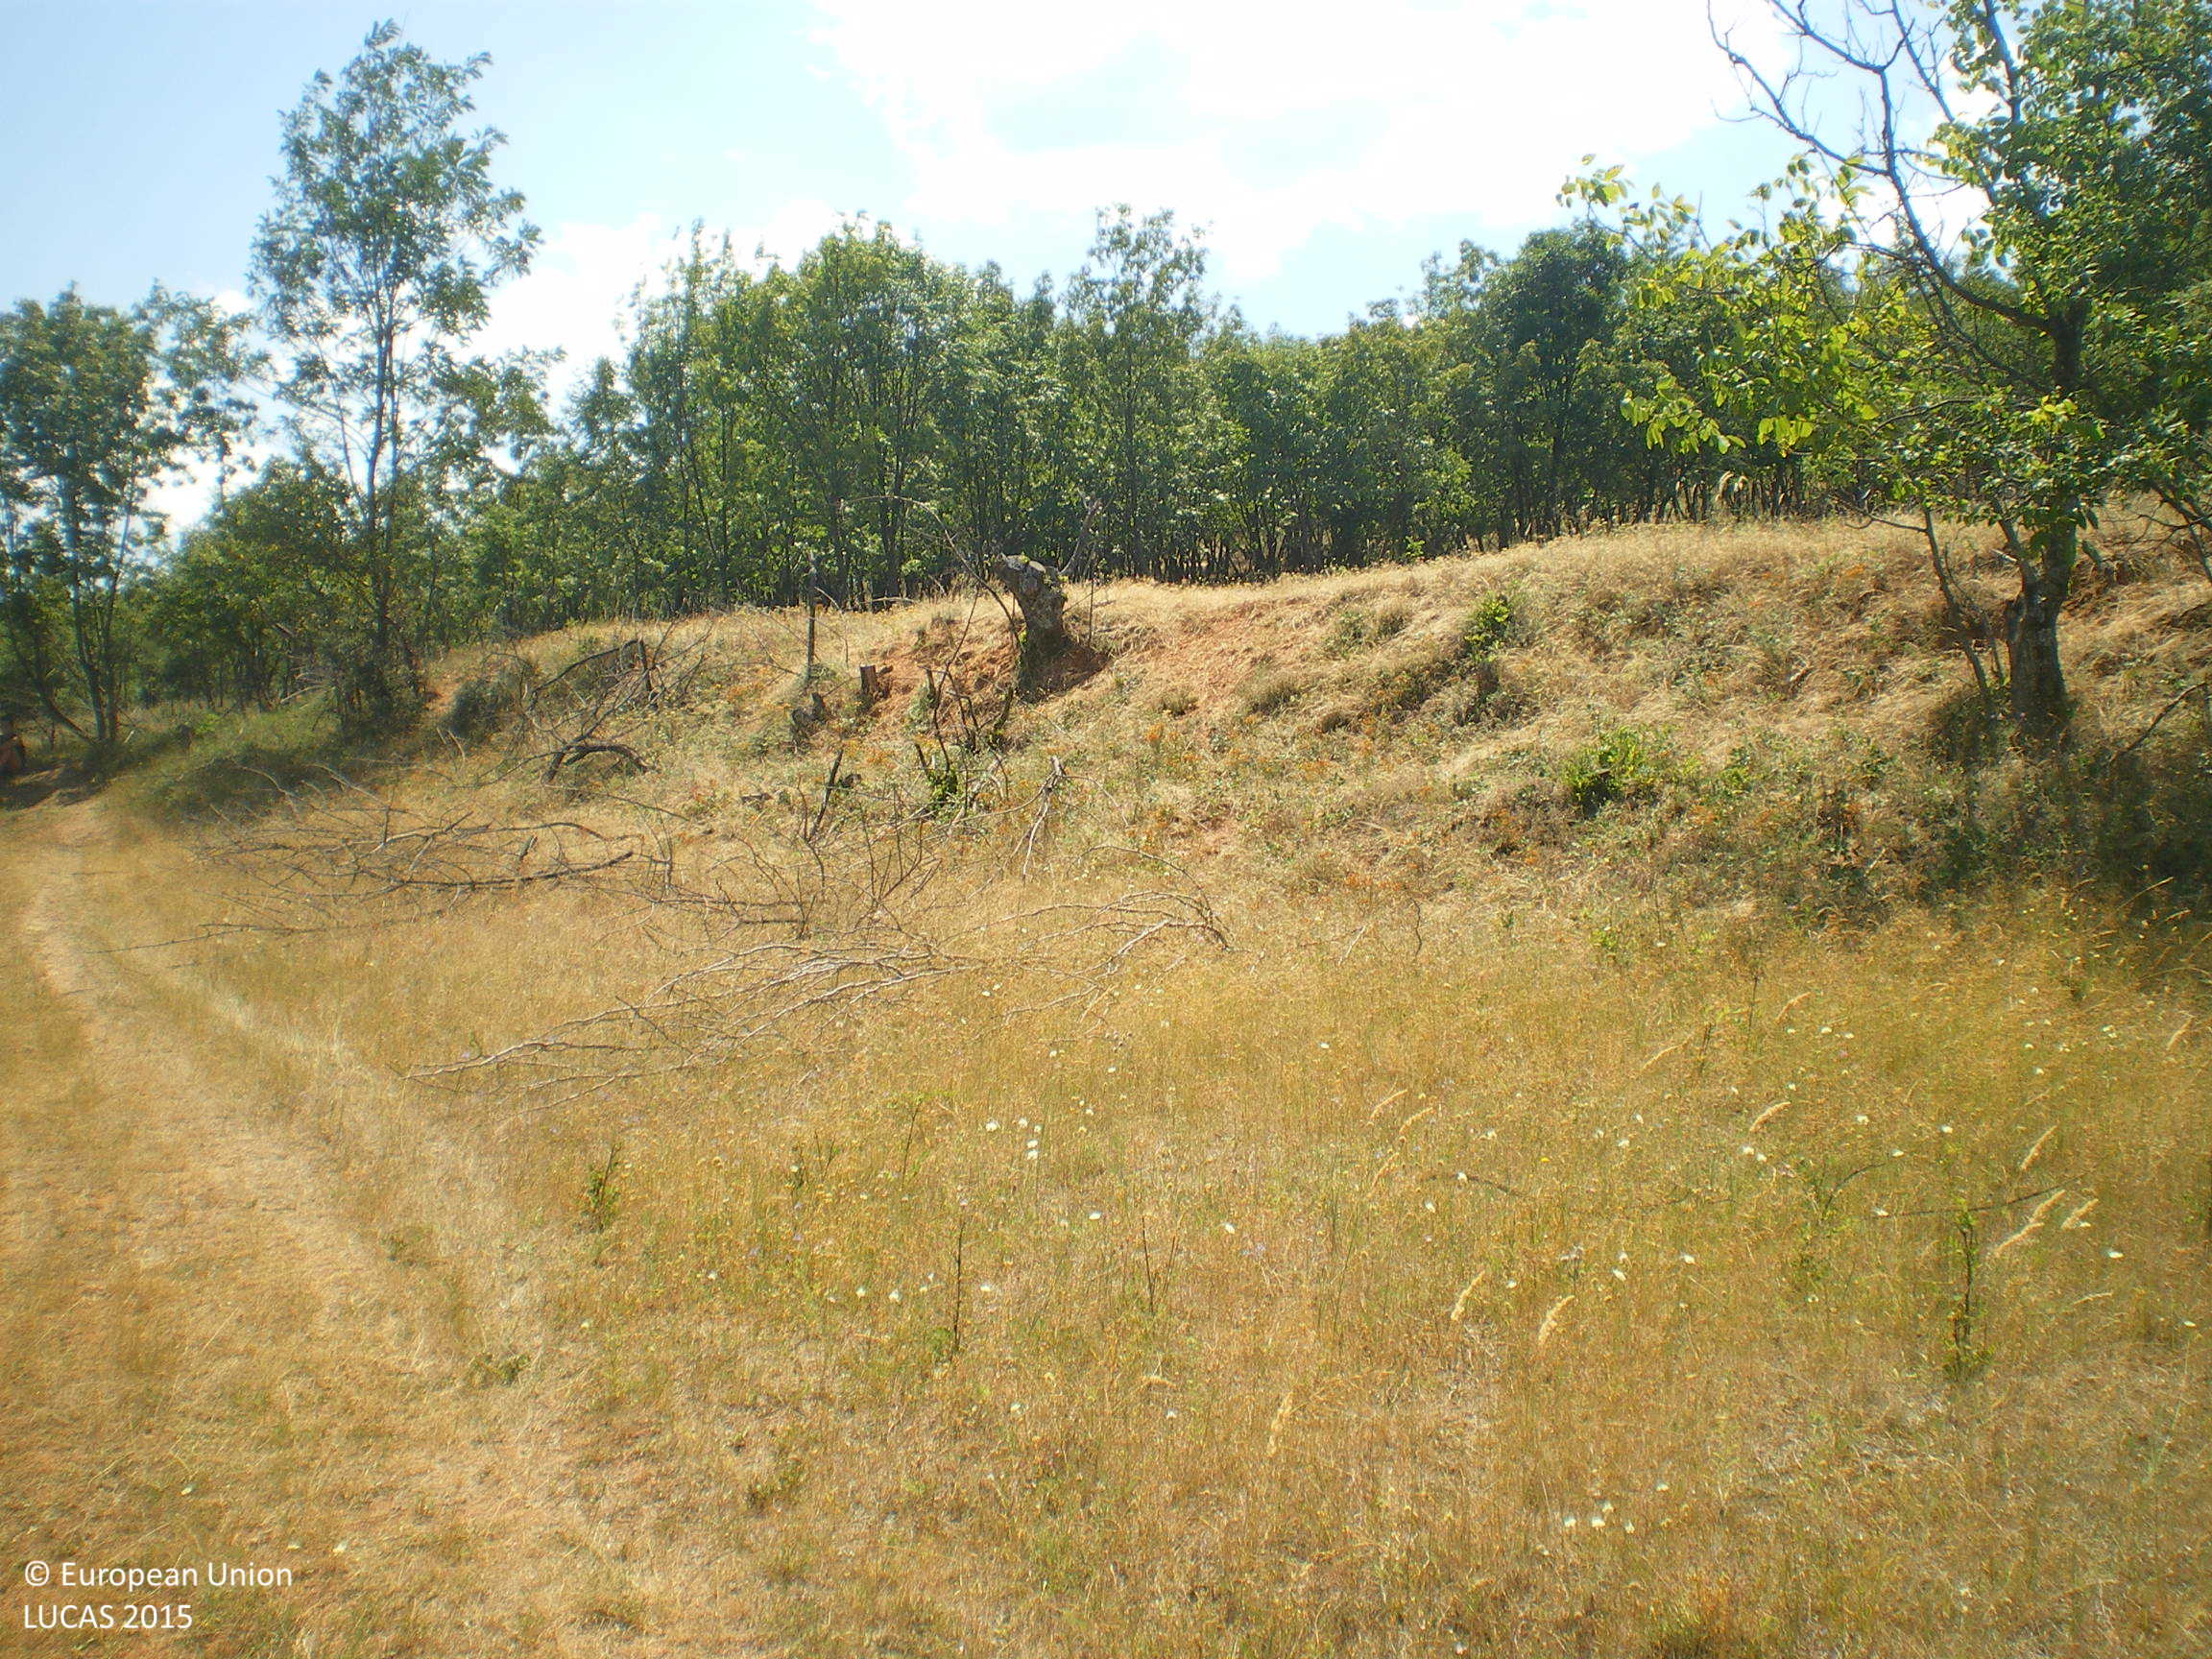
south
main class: Grassland
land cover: Grassland without tree/shrub cover
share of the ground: > 75 %
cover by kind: herbaceous plants 100 %
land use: Agriculture (excluding fallow land and kitchen gardens)
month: July
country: BG
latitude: 42.5802
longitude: 25.0858
